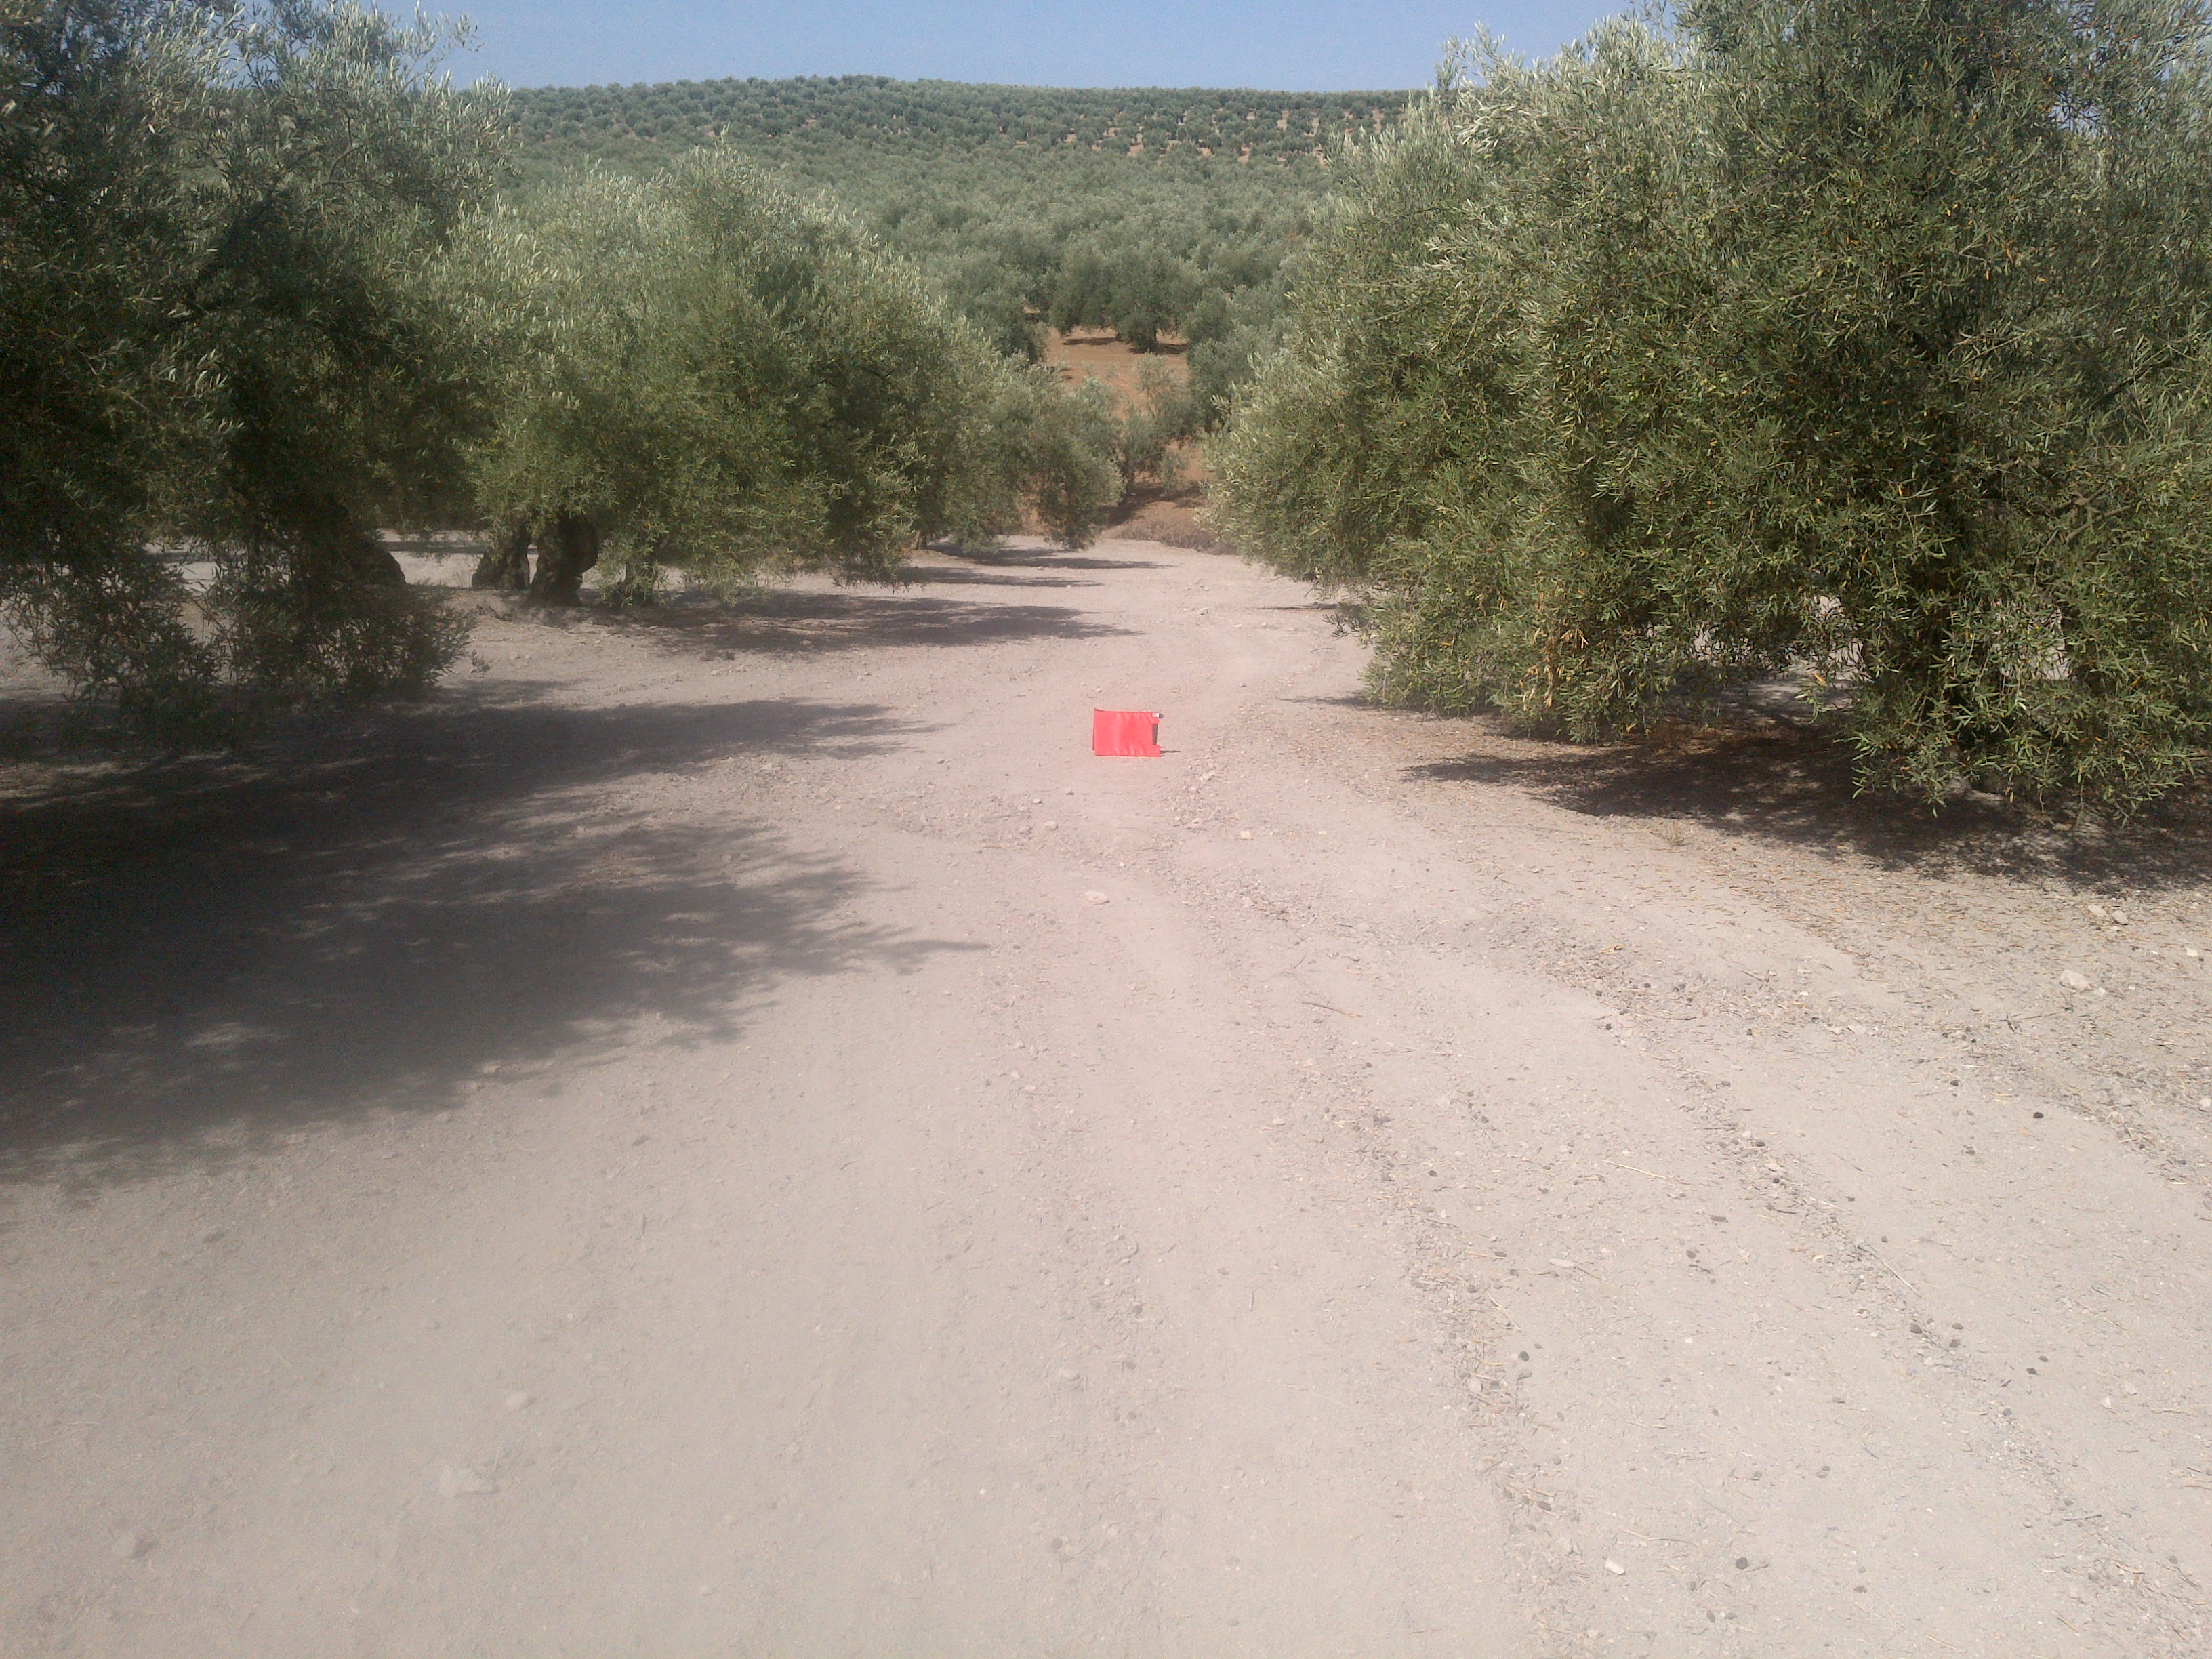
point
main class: Cropland
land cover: Olive groves
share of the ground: 50 - 75 %
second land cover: Other bare soil
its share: > 75 %
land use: Agriculture (excluding fallow land and kitchen gardens)
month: July
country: ES
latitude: 37.3958
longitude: -4.5408
